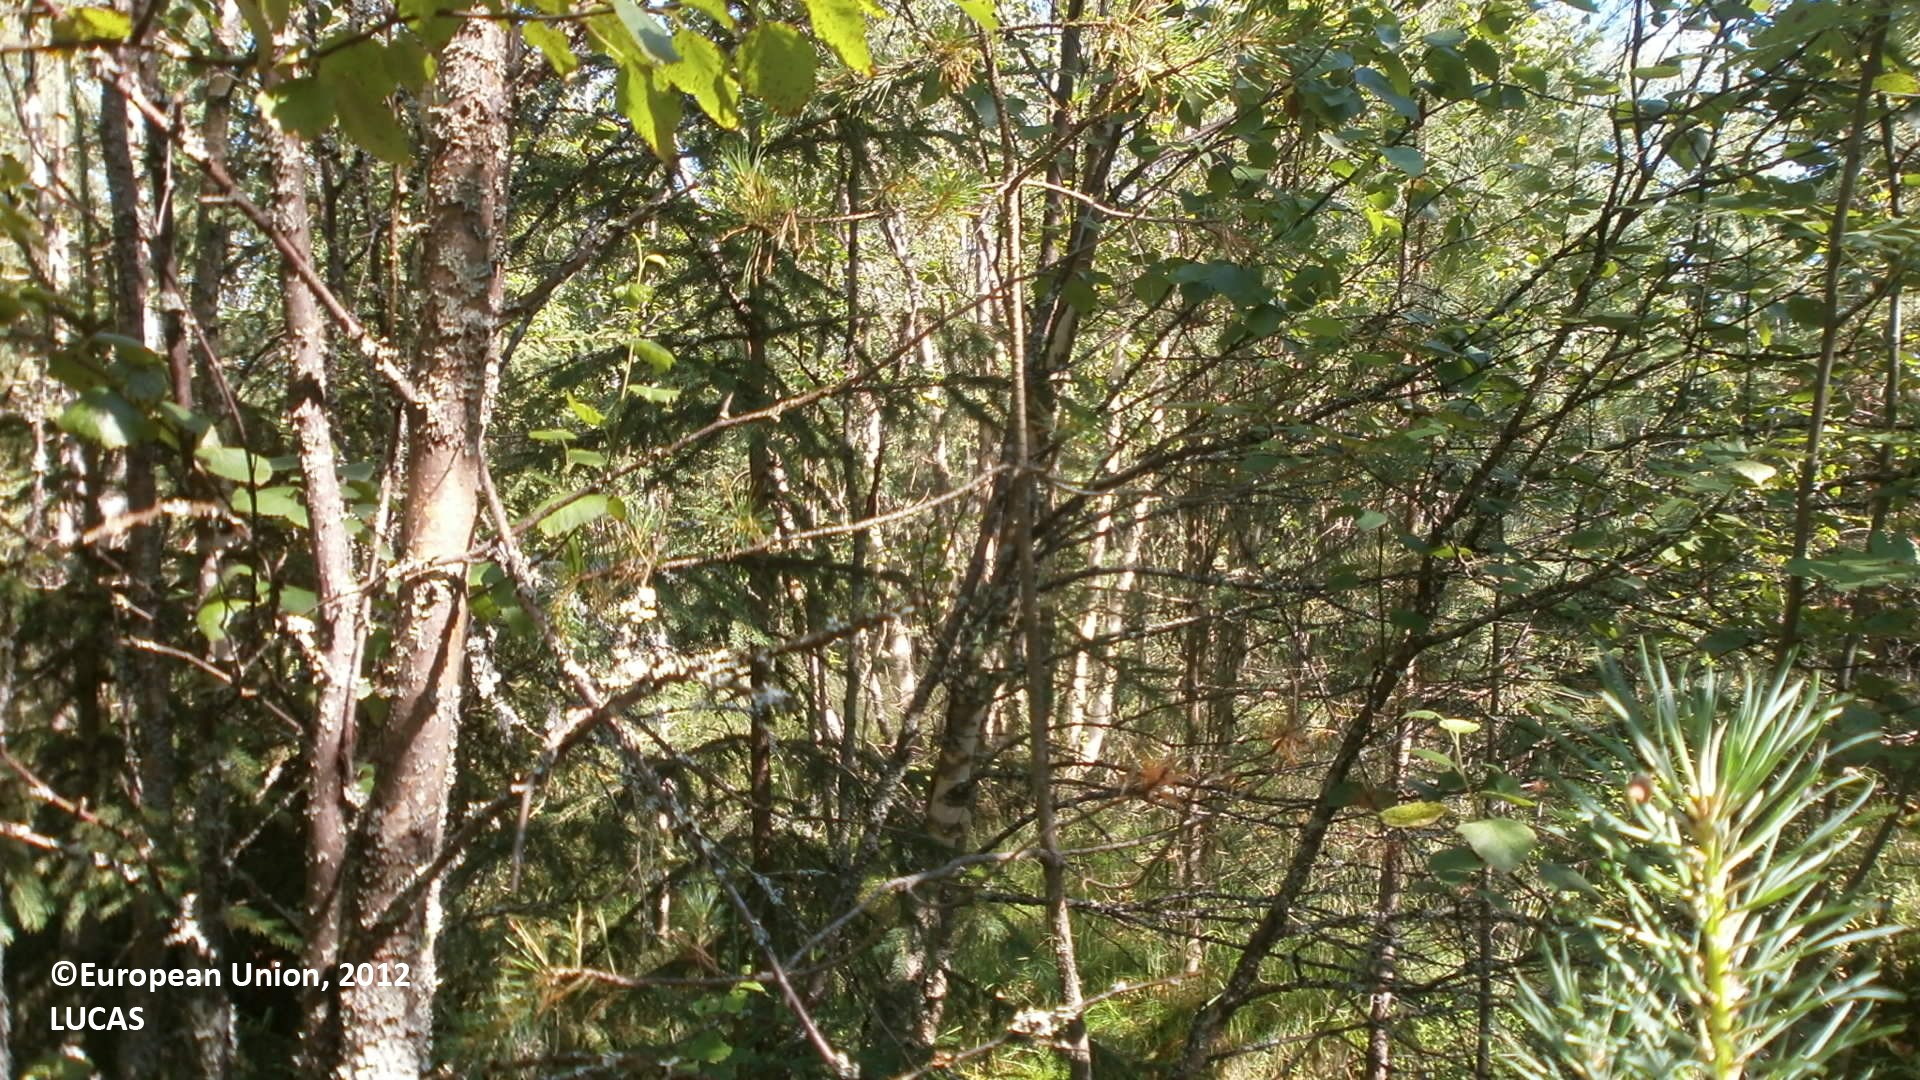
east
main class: Woodland
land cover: Pine dominated mixed woodland
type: boreal forest
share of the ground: > 75 %
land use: Forestry
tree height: > 5 m
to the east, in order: Pine dominated mixed woodland; Ditches and canals; Shruby margins; Tracks; Shruby margins; Abandoned hedges; Ditches and canals; Abandoned hedges; Spontaneously vegetated surfaces; Spruce dominated mixed woodland; Spontaneously vegetated surfaces; Ditches and canals; Shruby margins; Paved roads, cycling and walking lanes; Shruby margins; Ditches and canals; Other bare soil; Spruce dominated coniferous woodland; Ditches and canals; Spruce dominated coniferous woodland; Ditches and canals; Spruce dominated coniferous woodland; Ditches and canals; Spruce dominated mixed woodland; Pine dominated coniferous woodland
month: July
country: FI
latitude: 64.1296
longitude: 23.9280
